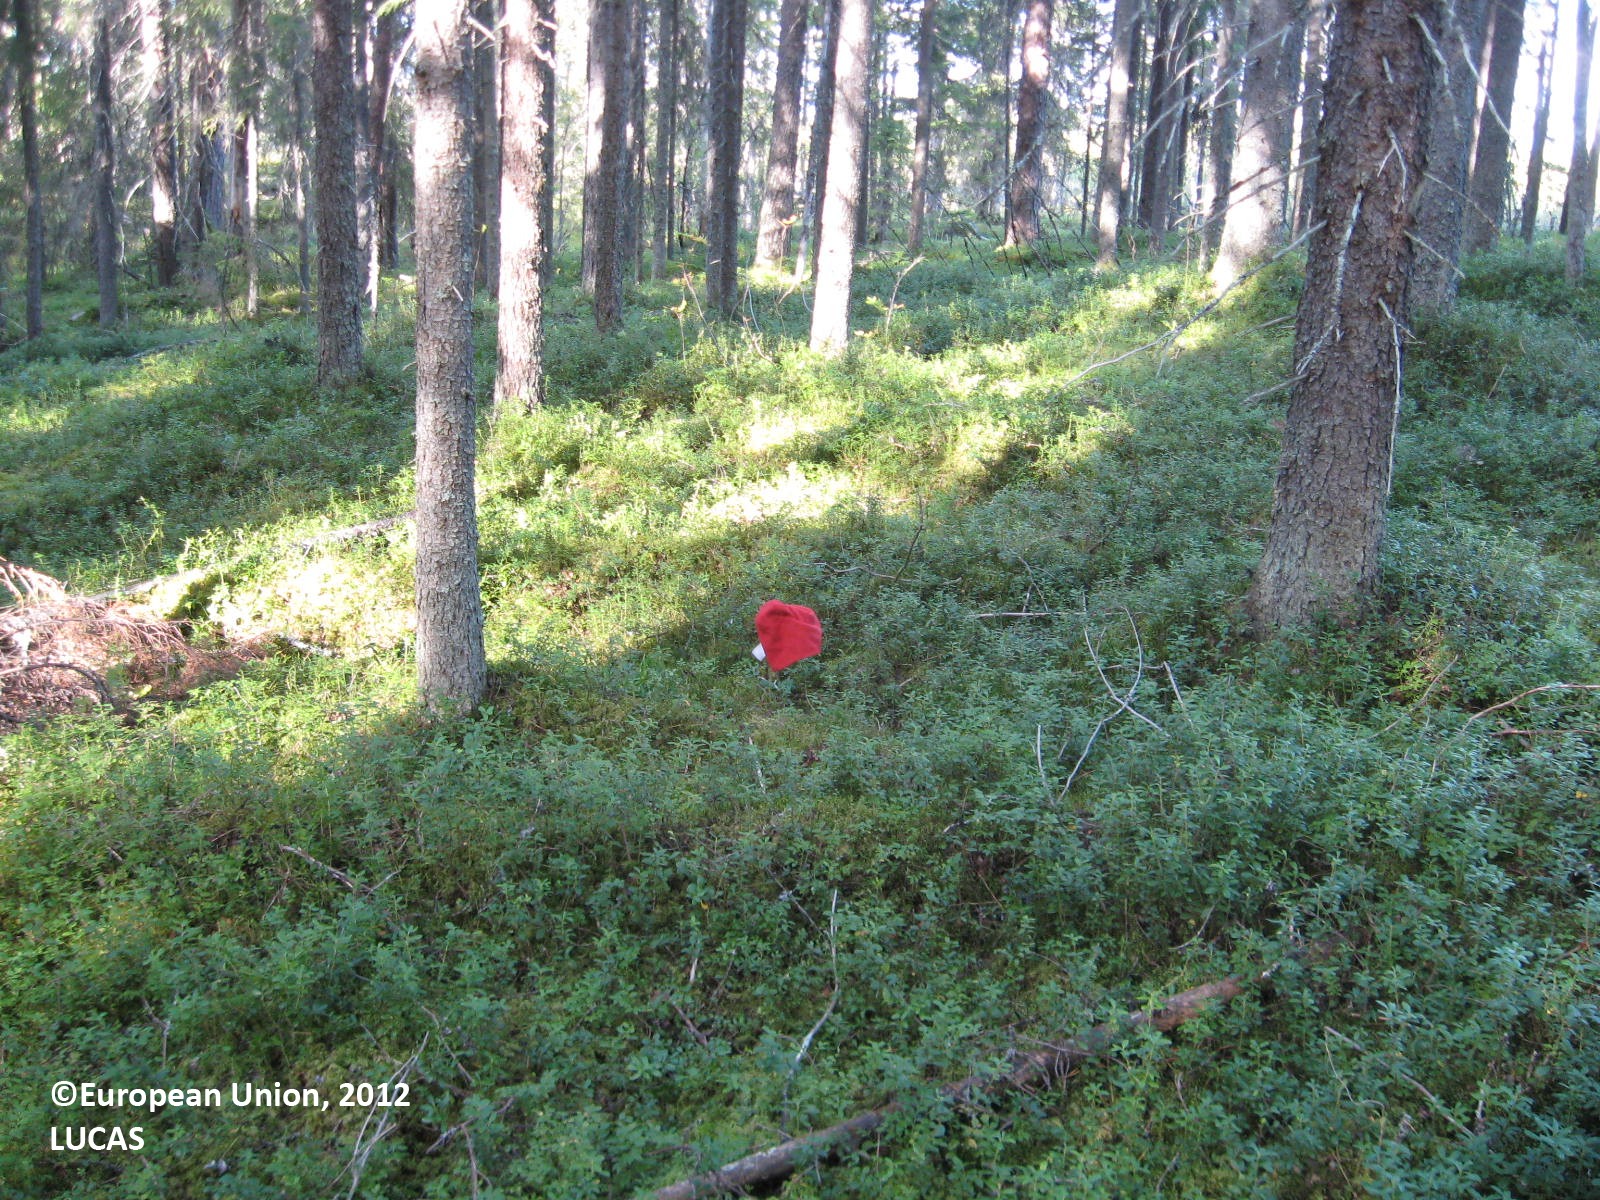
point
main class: Woodland
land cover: Spruce dominated coniferous woodland
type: boreal forest
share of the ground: > 75 %
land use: Forestry
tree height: > 5 m
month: August
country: FI
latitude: 63.8606
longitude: 30.0825
